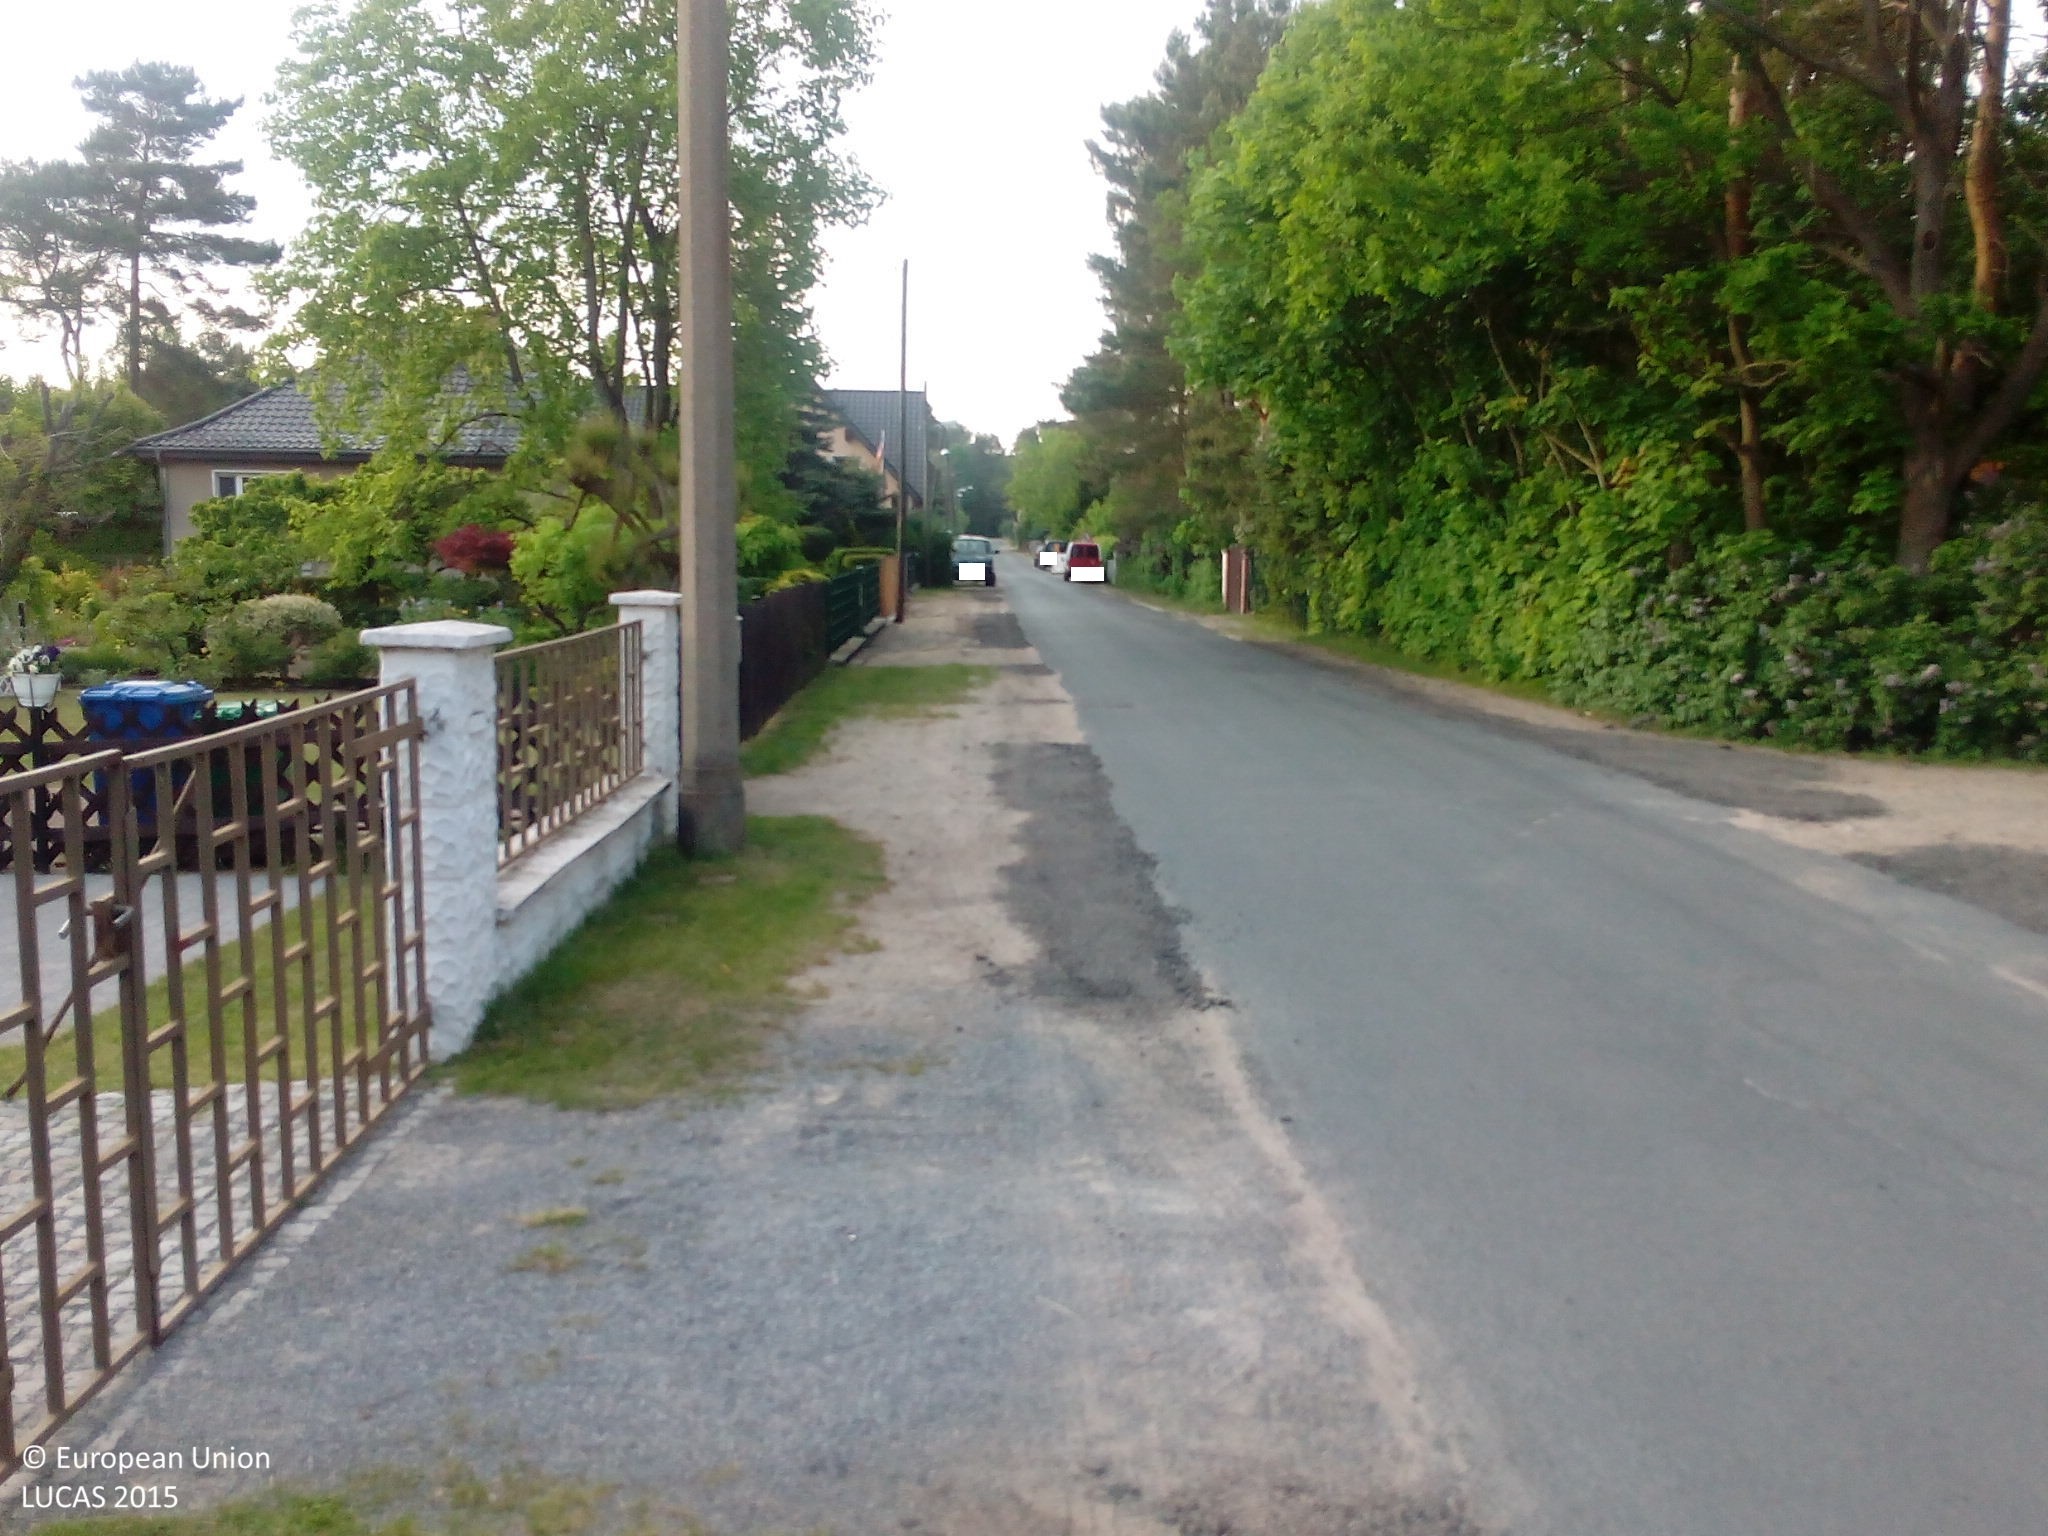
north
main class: Woodland
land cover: Pine dominated mixed woodland
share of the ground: 25 - 50 %
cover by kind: coniferous forest trees 25 %, broadleaved forest trees 25 %, consolidated bare surface 25 %, herbaceous plants 15 %, shrubs 10 %
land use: Residential
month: May
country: DE
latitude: 52.1022
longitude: 13.1388
